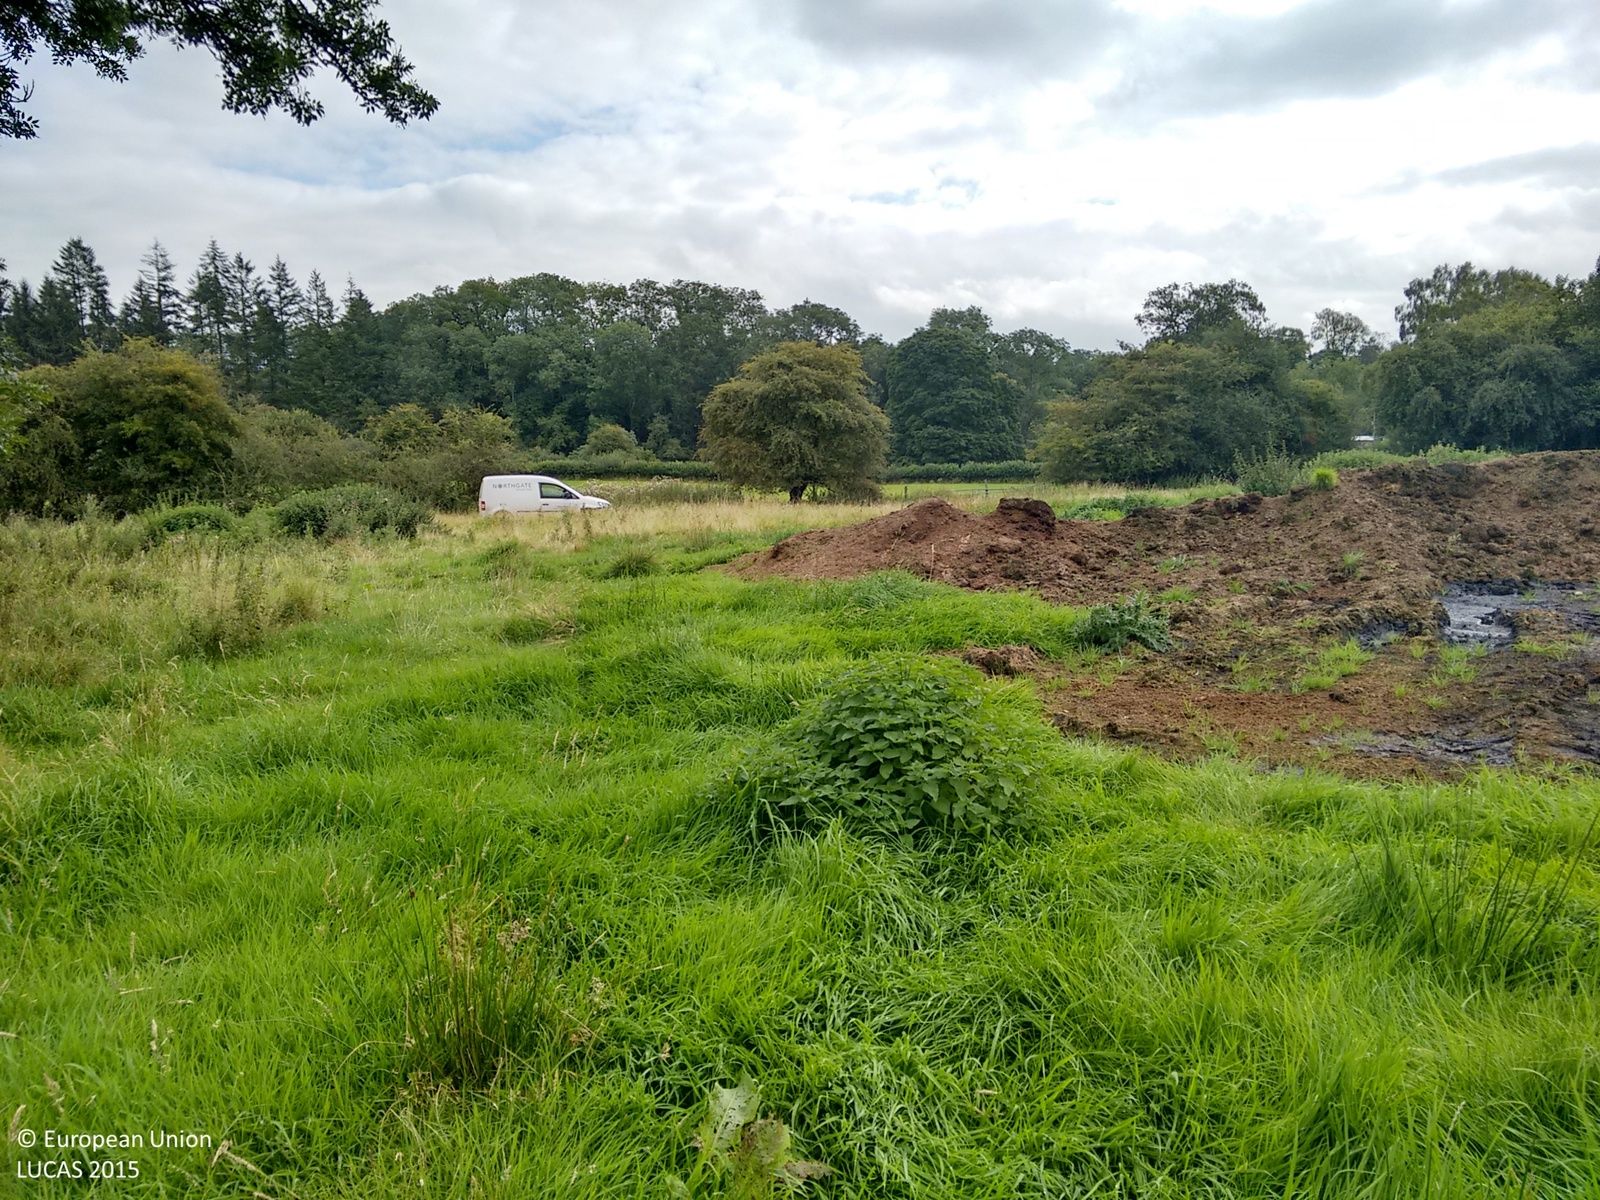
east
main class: Grassland
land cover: Grassland with sparse tree/shrub cover
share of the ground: > 75 %
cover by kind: herbaceous plants 95 %, broadleaved forest trees 5 %
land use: Semi-natural and natural areas not in use
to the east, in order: Grassland with sparse tree/shrub cover; Grassland without tree/shrub cover; Tracks; Grassland without tree/shrub cover; Shruby margins; Single bushes/trees; Fences; Grassland without tree/shrub cover; Managed hedges; Grassland with sparse tree/shrub cover; Inland fresh running water; Broadleaved woodland; Grassland without tree/shrub cover
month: September
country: GB
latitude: 52.2275
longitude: -3.4501
